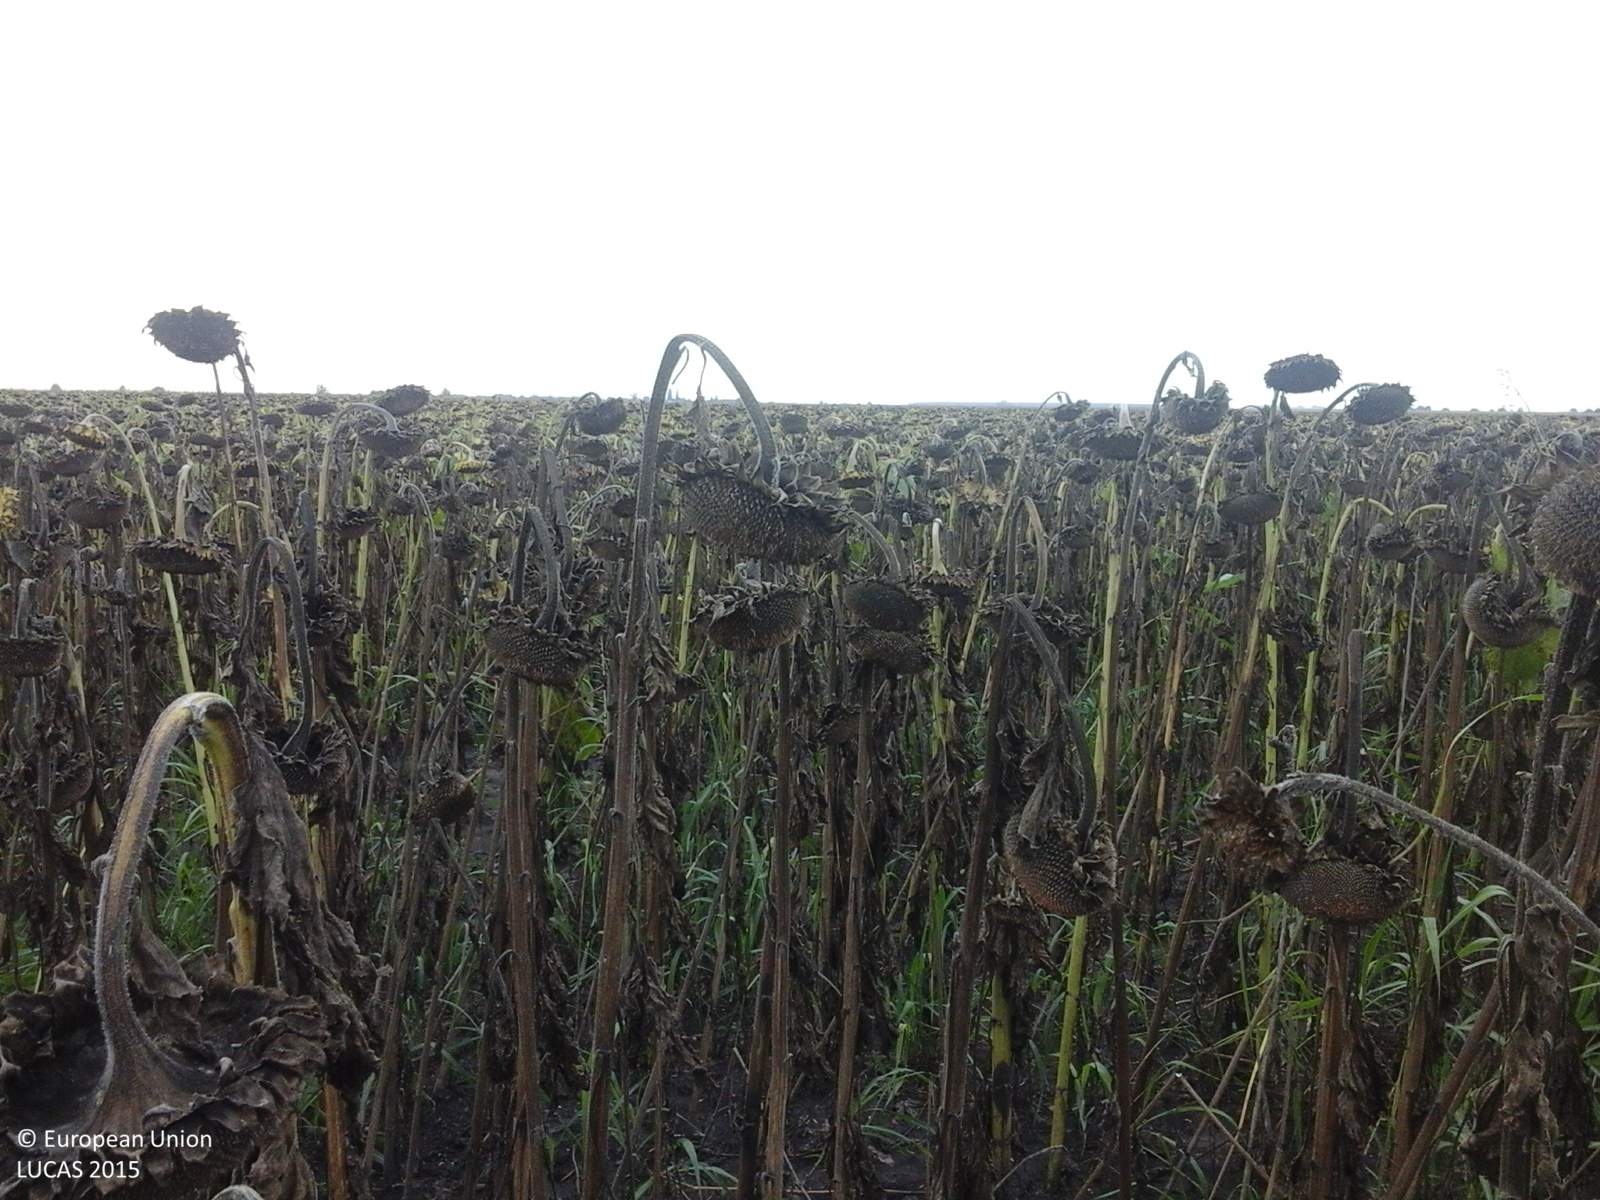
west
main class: Cropland
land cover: Sunflower
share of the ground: > 75 %
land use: Agriculture (excluding fallow land and kitchen gardens)
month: August
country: RO
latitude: 46.2872
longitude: 21.2087
